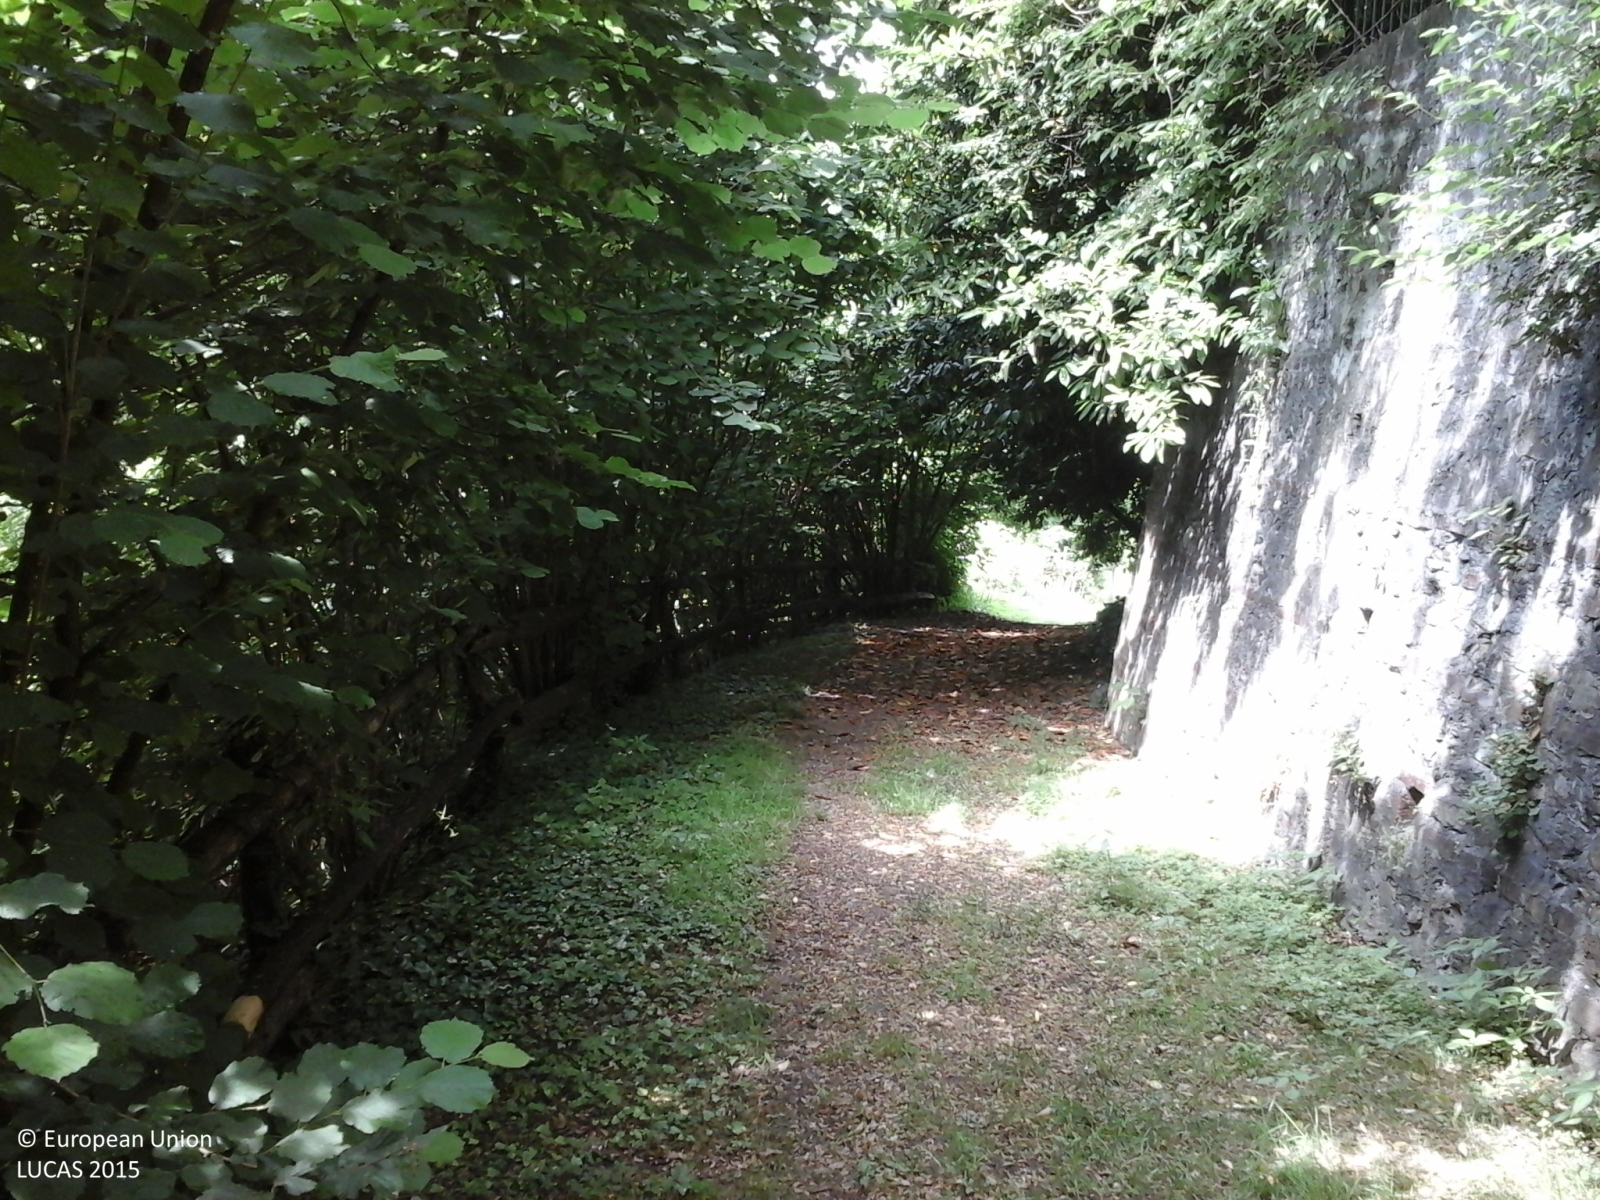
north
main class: Woodland
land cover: Broadleaved woodland
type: thermophilous deciduous forest
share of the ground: > 75 %
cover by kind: broadleaved forest trees 100 %
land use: Semi-natural and natural areas not in use
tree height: > 5 m
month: June
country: IT
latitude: 45.1024
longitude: 7.7799
